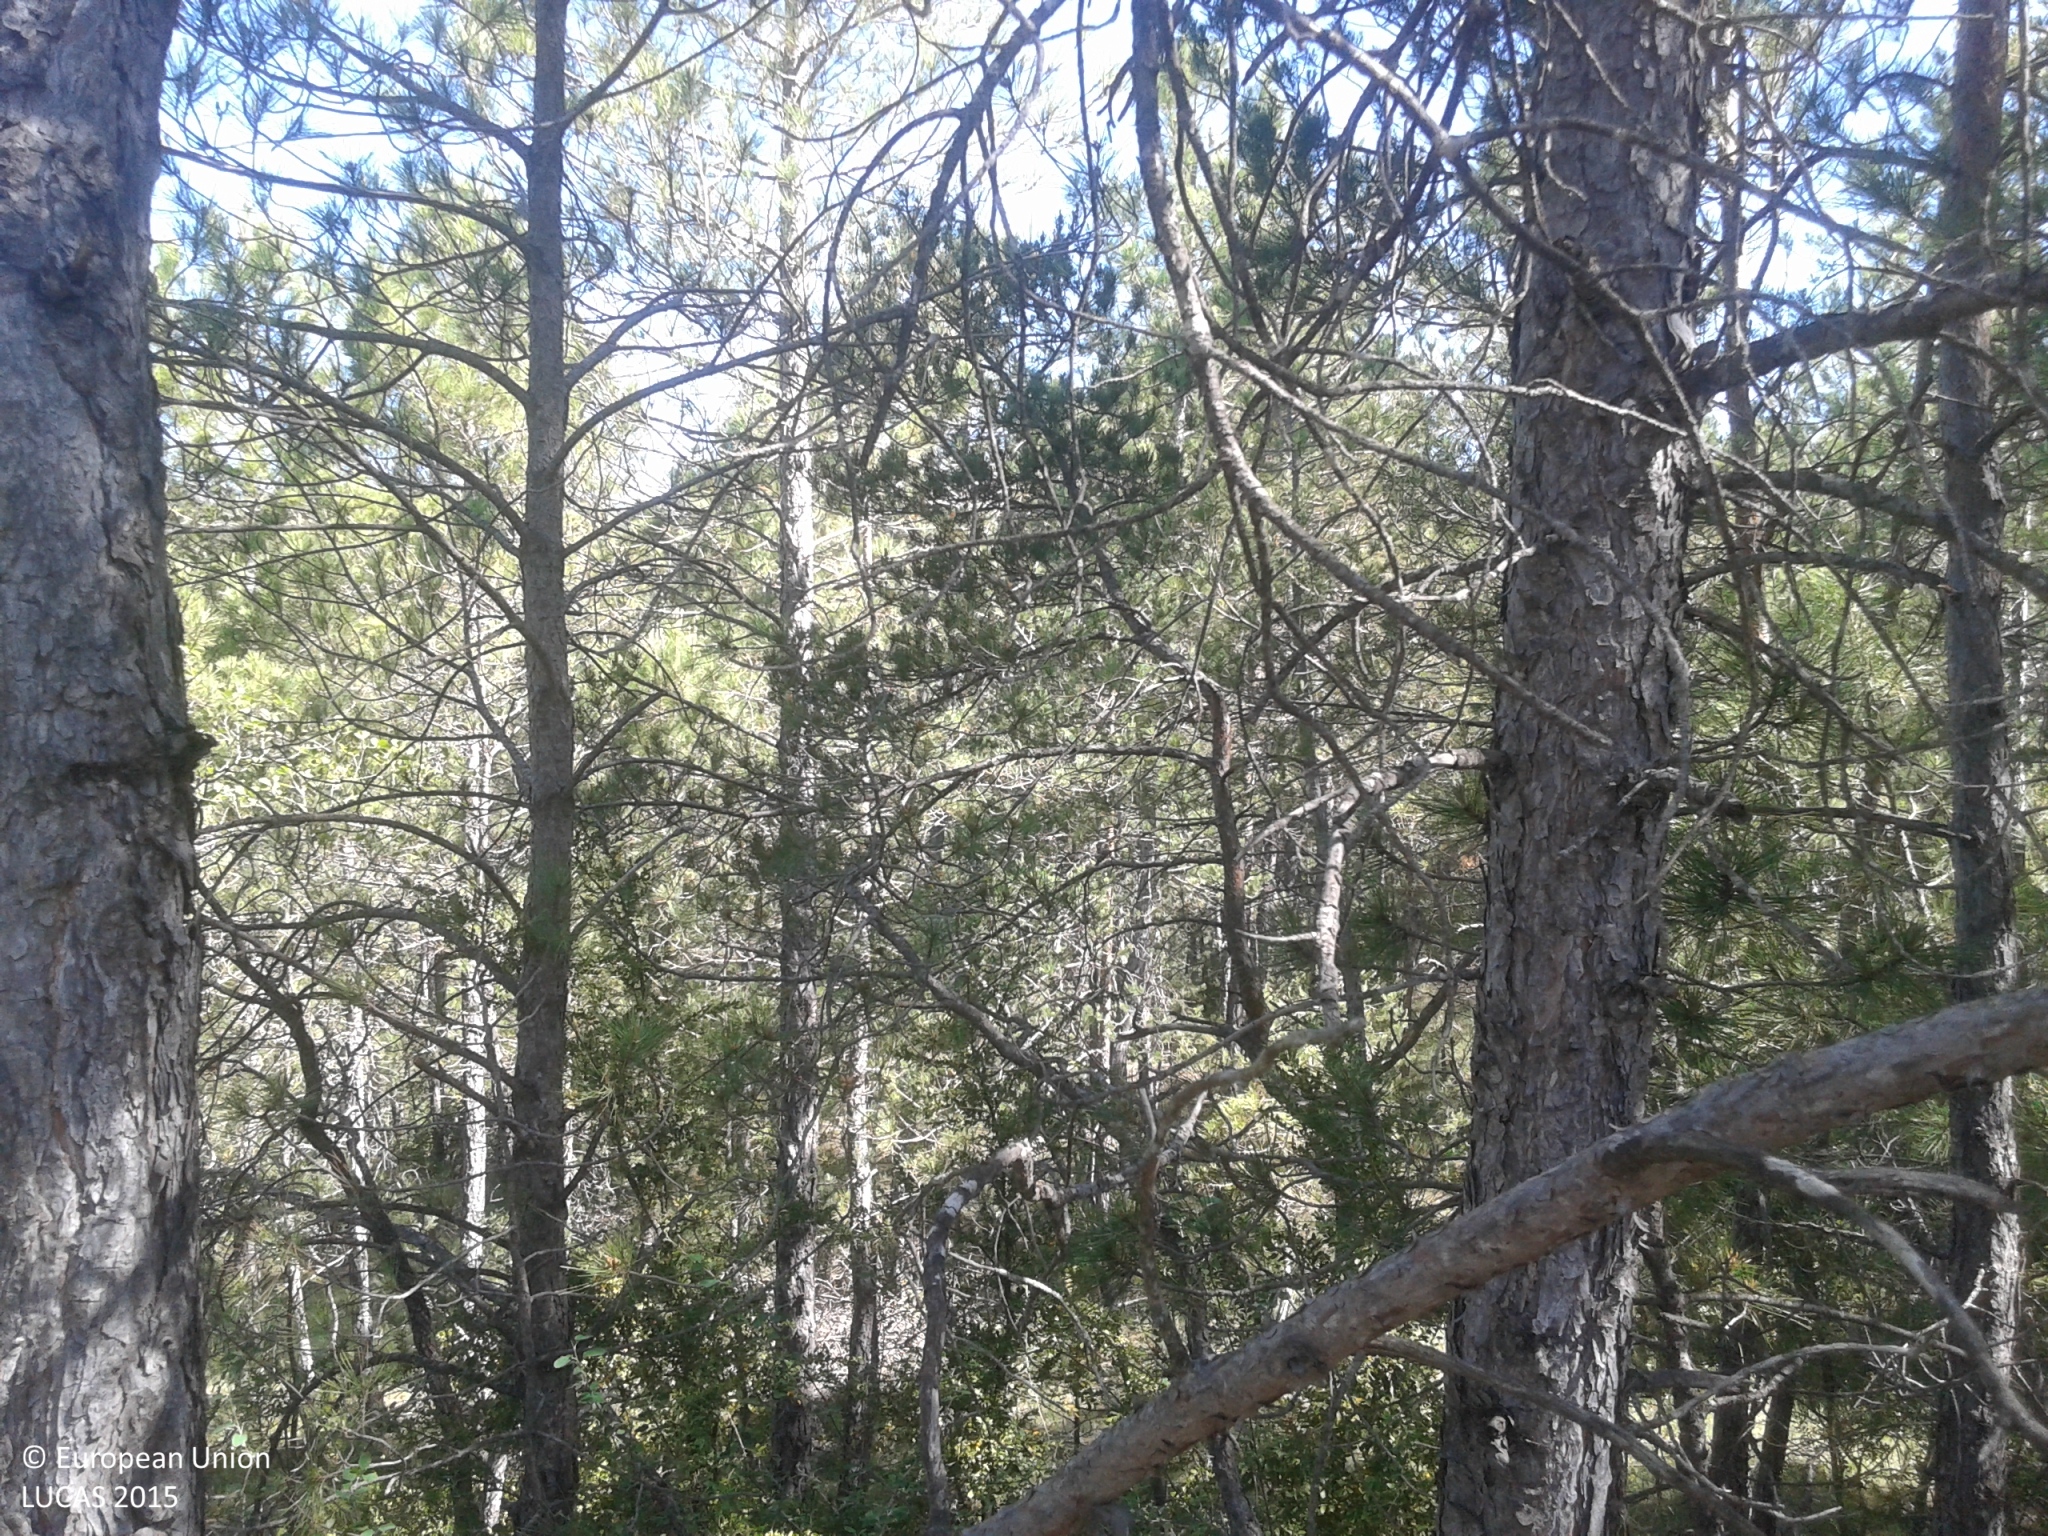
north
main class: Woodland
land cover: Pine dominated coniferous woodland
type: coniferous forest of the mediterranean region
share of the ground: > 75 %
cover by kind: coniferous forest trees 75 %, shrubs 15 %, broadleaved forest trees 10 %
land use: Forestry
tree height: > 5 m
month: May
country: ES
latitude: 42.0139
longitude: 1.5961
